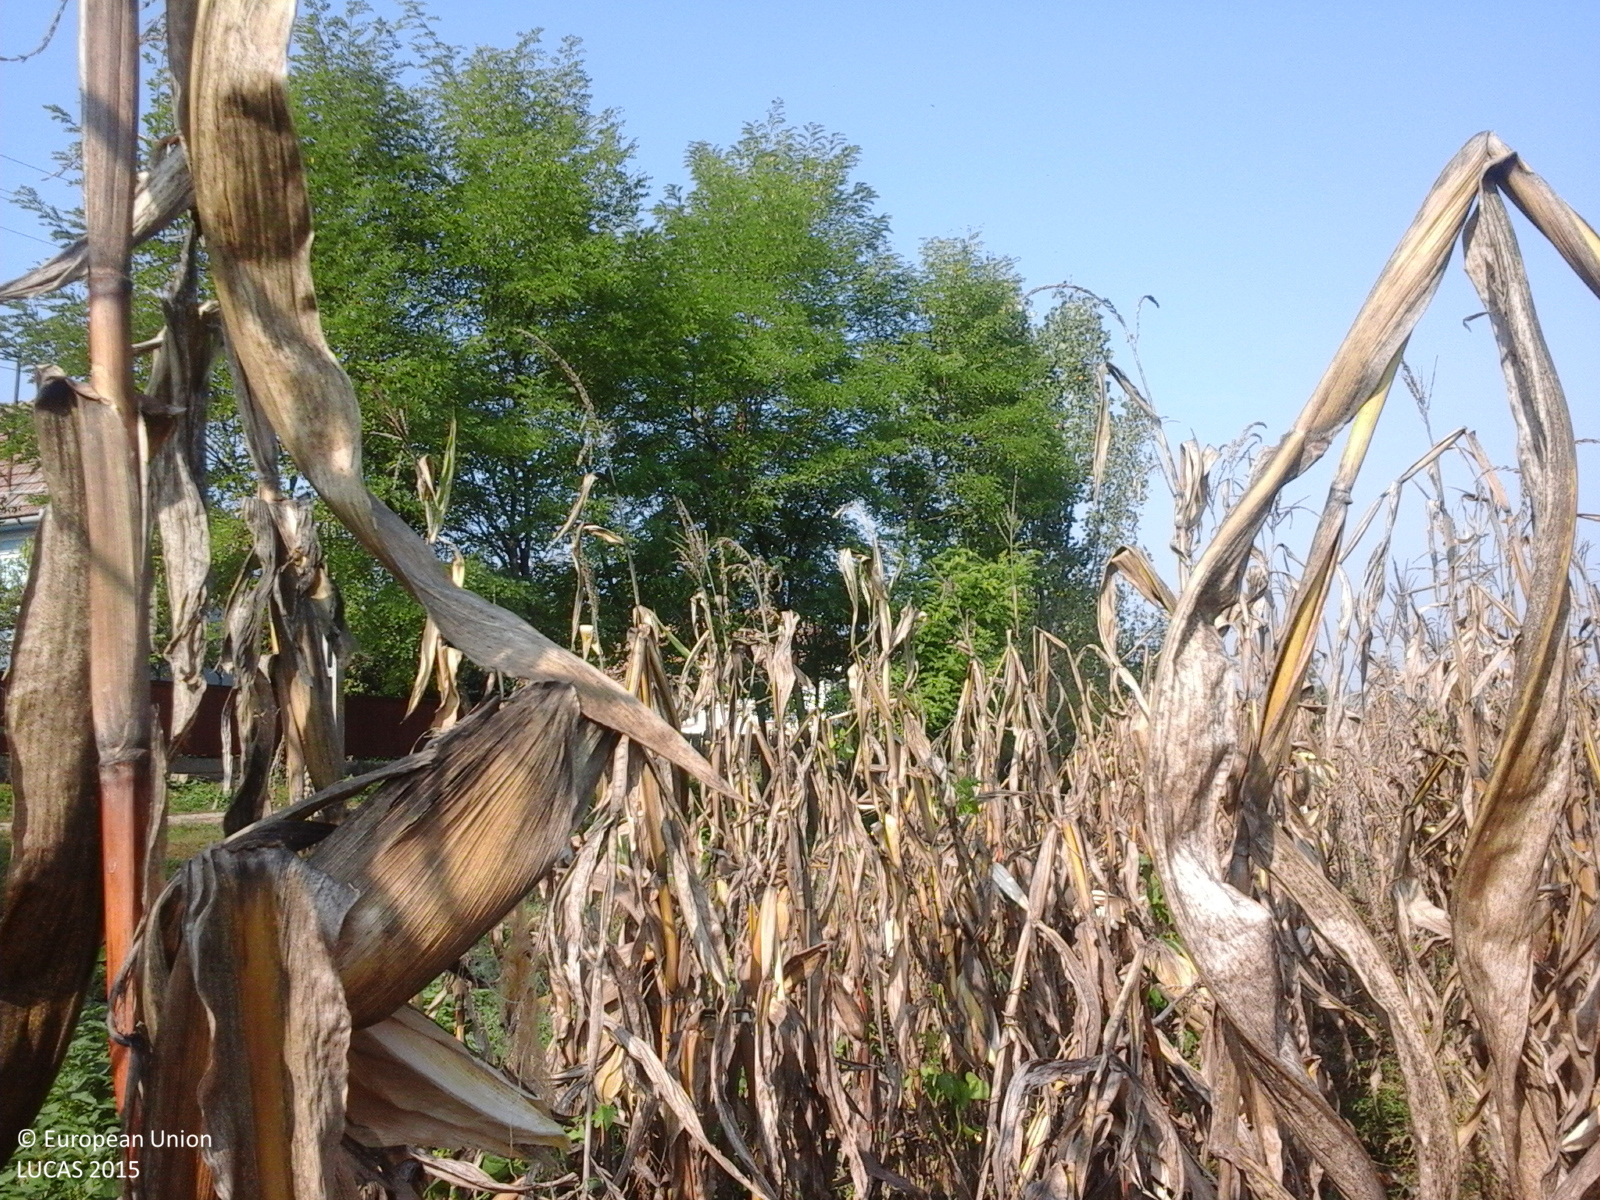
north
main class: Cropland
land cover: Maize
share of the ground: > 75 %
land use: Agriculture (excluding fallow land and kitchen gardens)
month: October
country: RO
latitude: 46.5588
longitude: 24.1285
